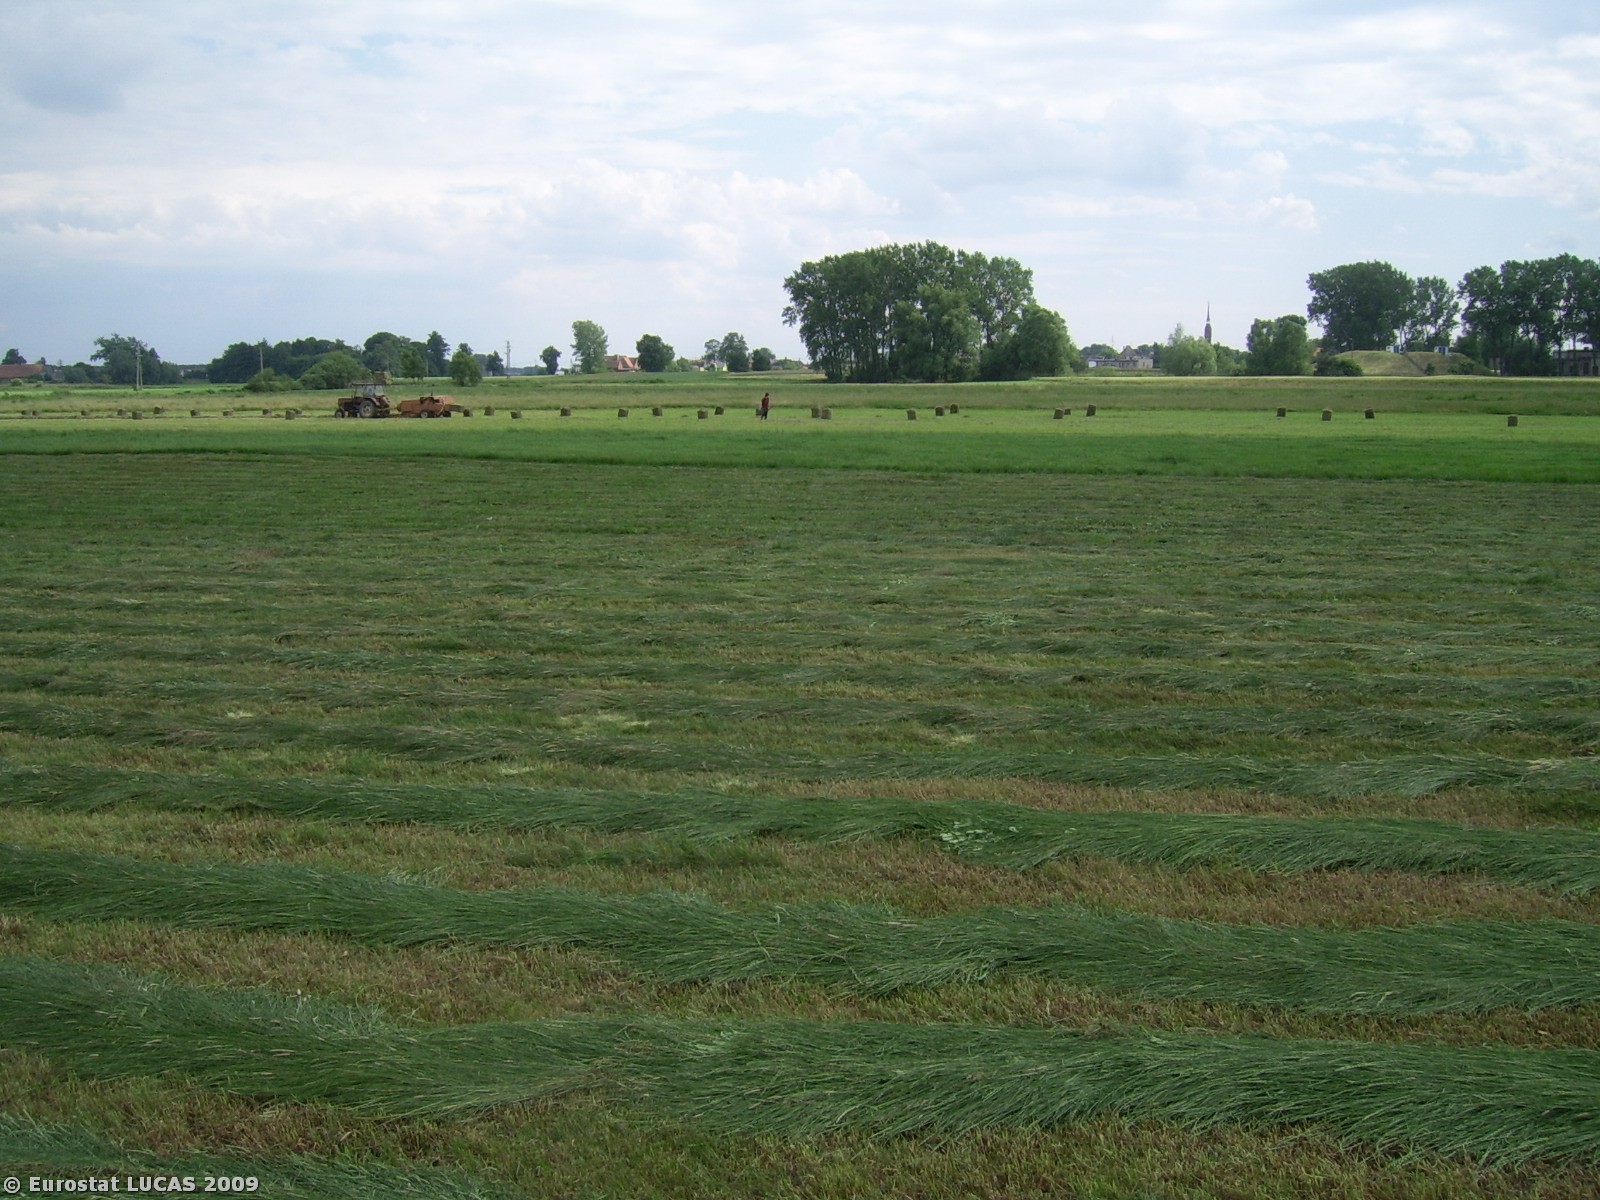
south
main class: Cropland
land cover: Triticale
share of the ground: > 75 %
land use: Agriculture (excluding fallow land and kitchen gardens)
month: June
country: PL
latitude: 51.7279
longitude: 17.7309
